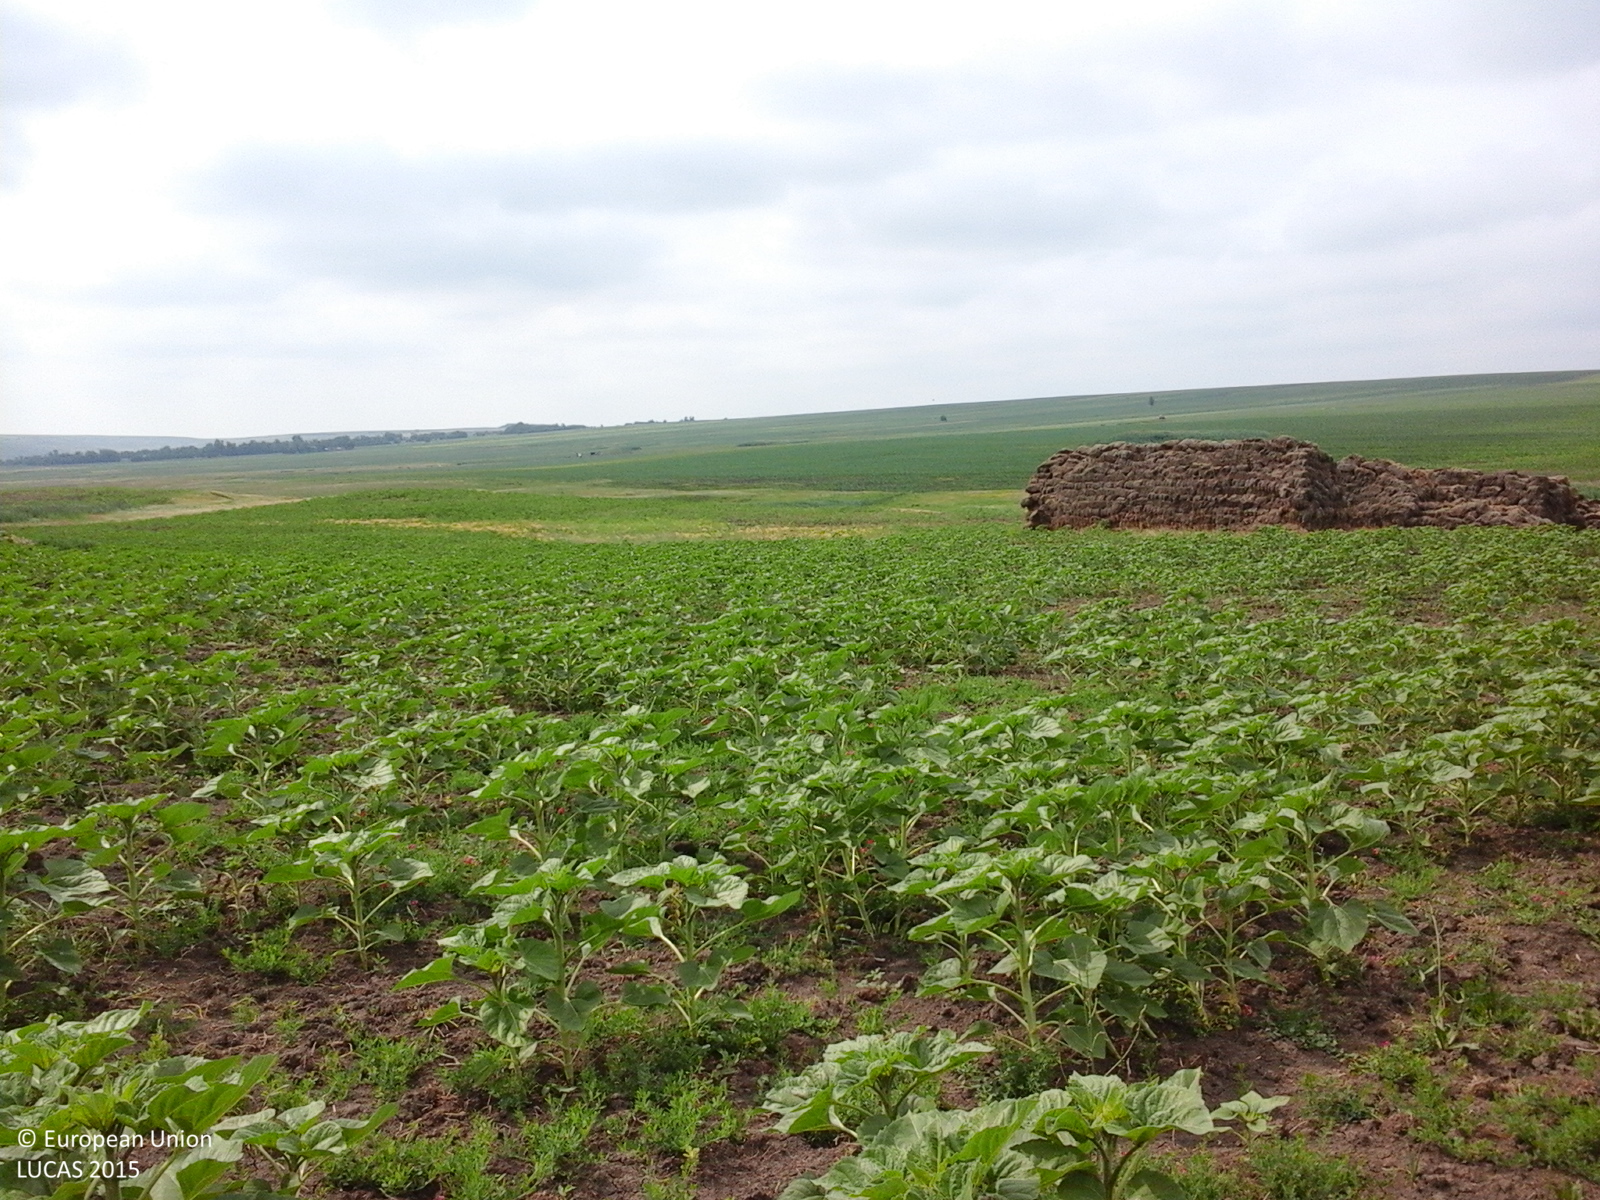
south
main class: Cropland
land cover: Sunflower
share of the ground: 25 - 50 %
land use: Agriculture (excluding fallow land and kitchen gardens)
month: June
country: RO
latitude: 47.9528
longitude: 26.5500
